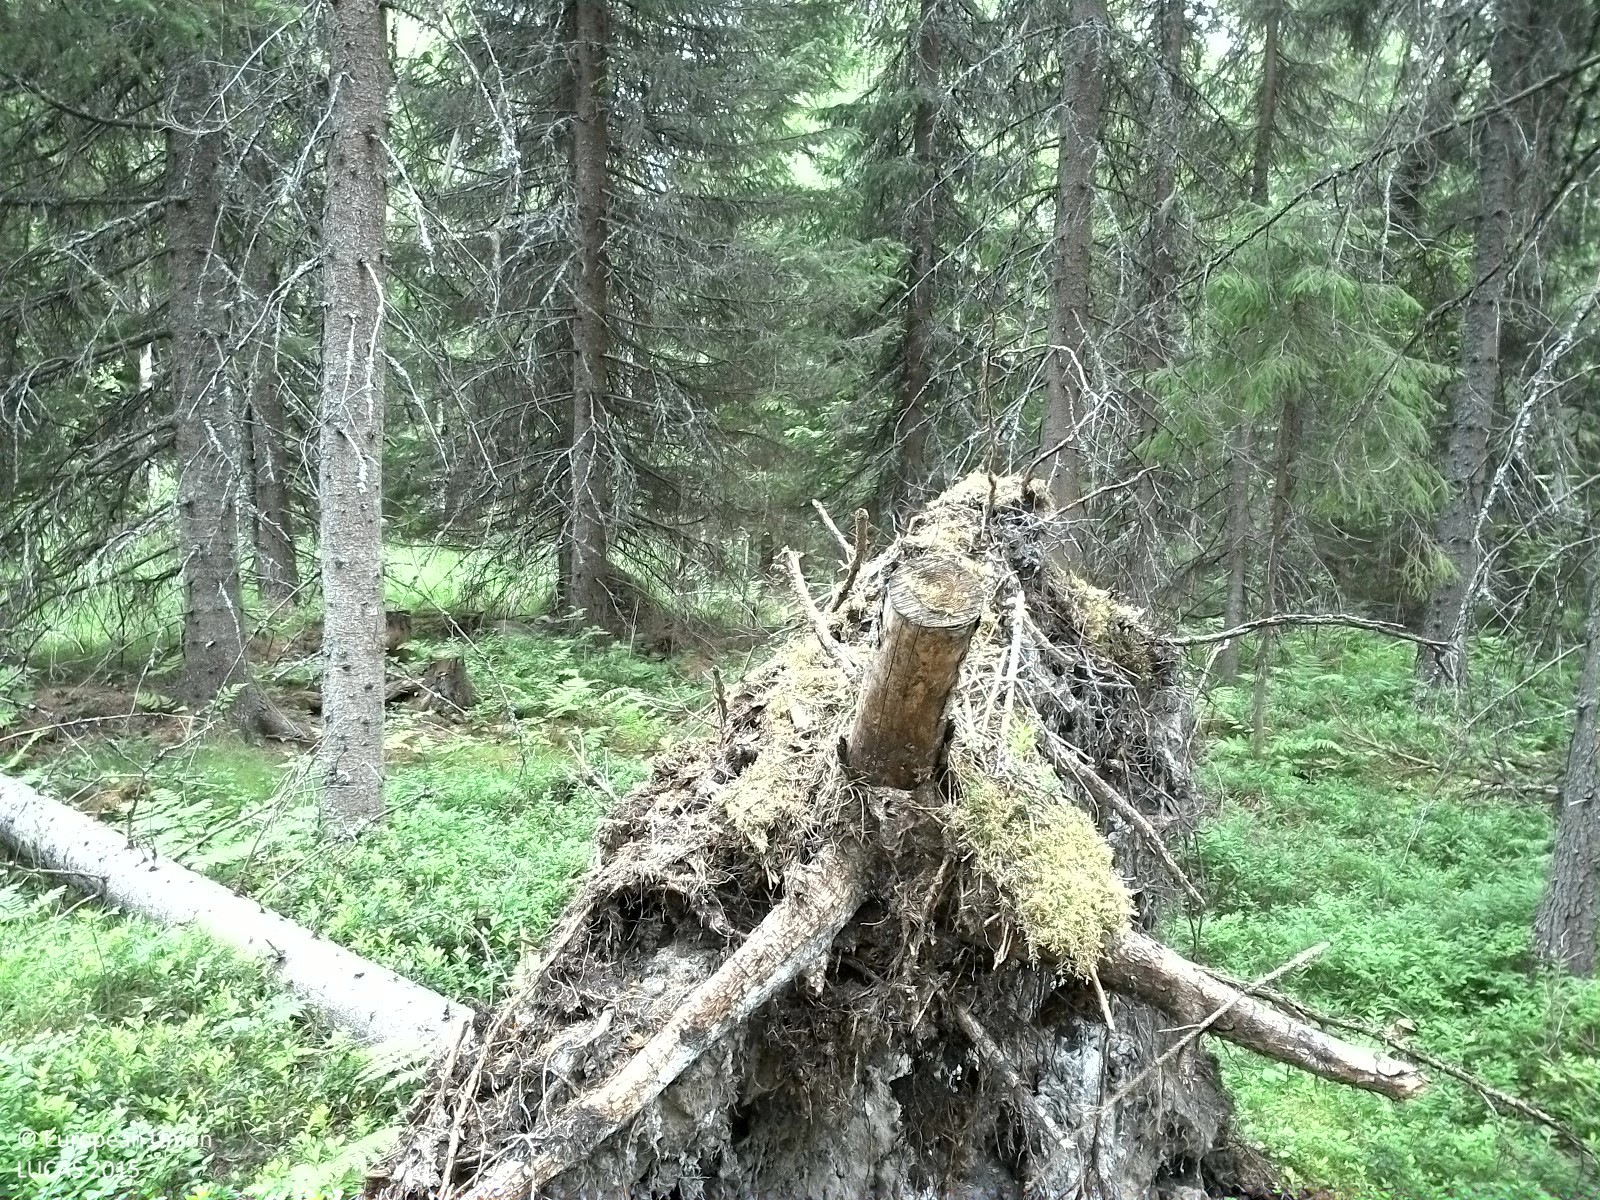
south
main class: Woodland
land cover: Spruce dominated coniferous woodland
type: boreal forest
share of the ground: 25 - 50 %
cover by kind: coniferous forest trees 45 %, shrubs 35 %, herbaceous plants 10 %, lichens and mosses 10 %
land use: Forestry
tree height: > 5 m
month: July
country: SE
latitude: 62.1246
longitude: 16.9793
